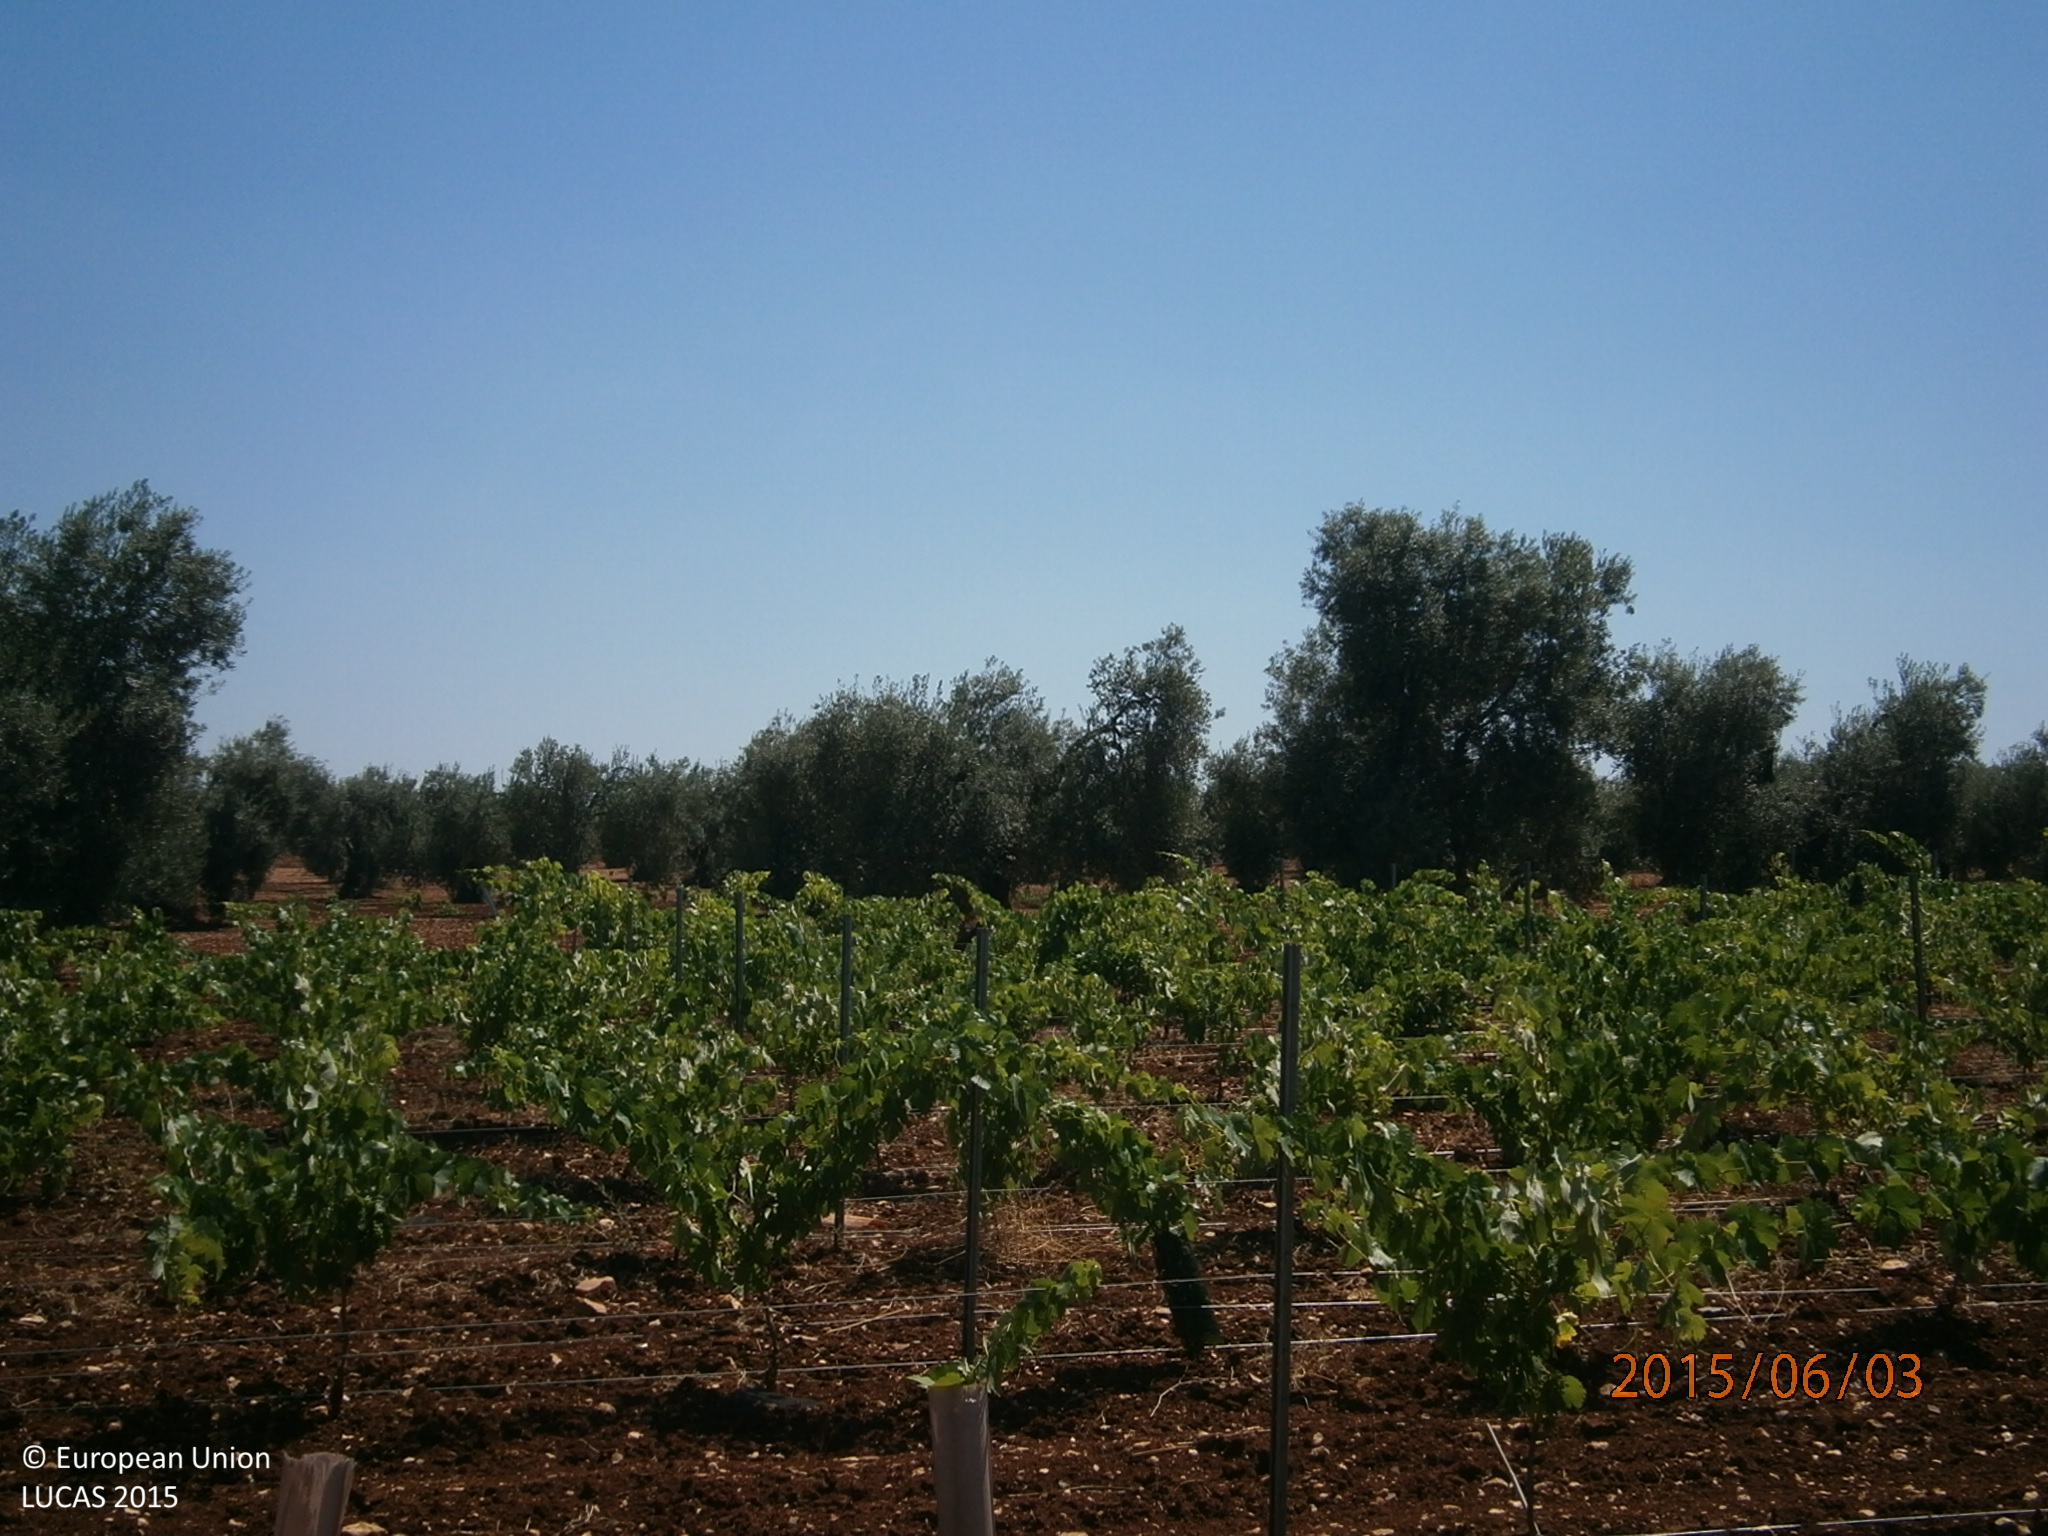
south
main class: Cropland
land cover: Olive groves
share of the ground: 10 - 25 %
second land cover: Other bare soil
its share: > 75 %
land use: Agriculture (excluding fallow land and kitchen gardens)
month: June
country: ES
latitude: 38.6192
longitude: -6.3971
